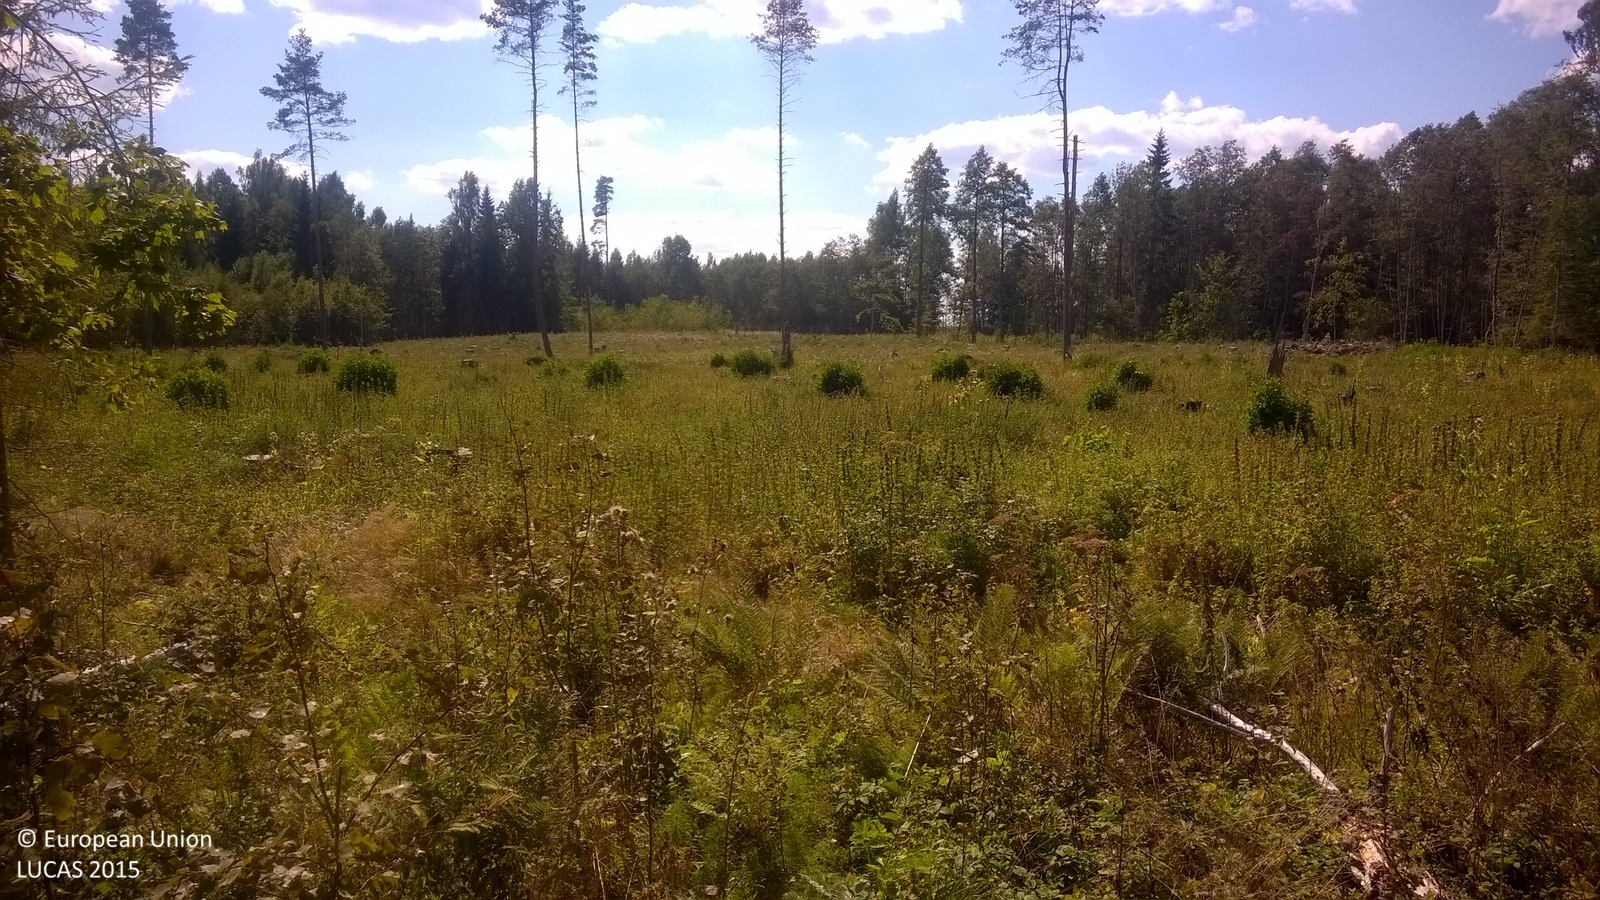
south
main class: Grassland
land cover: Grassland with sparse tree/shrub cover
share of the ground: > 75 %
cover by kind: herbaceous plants 85 %, shrubs 10 %, broadleaved forest trees 5 %
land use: Forestry
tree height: > 5 m
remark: Clear cut
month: August
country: LV
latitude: 57.8666
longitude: 25.7800
